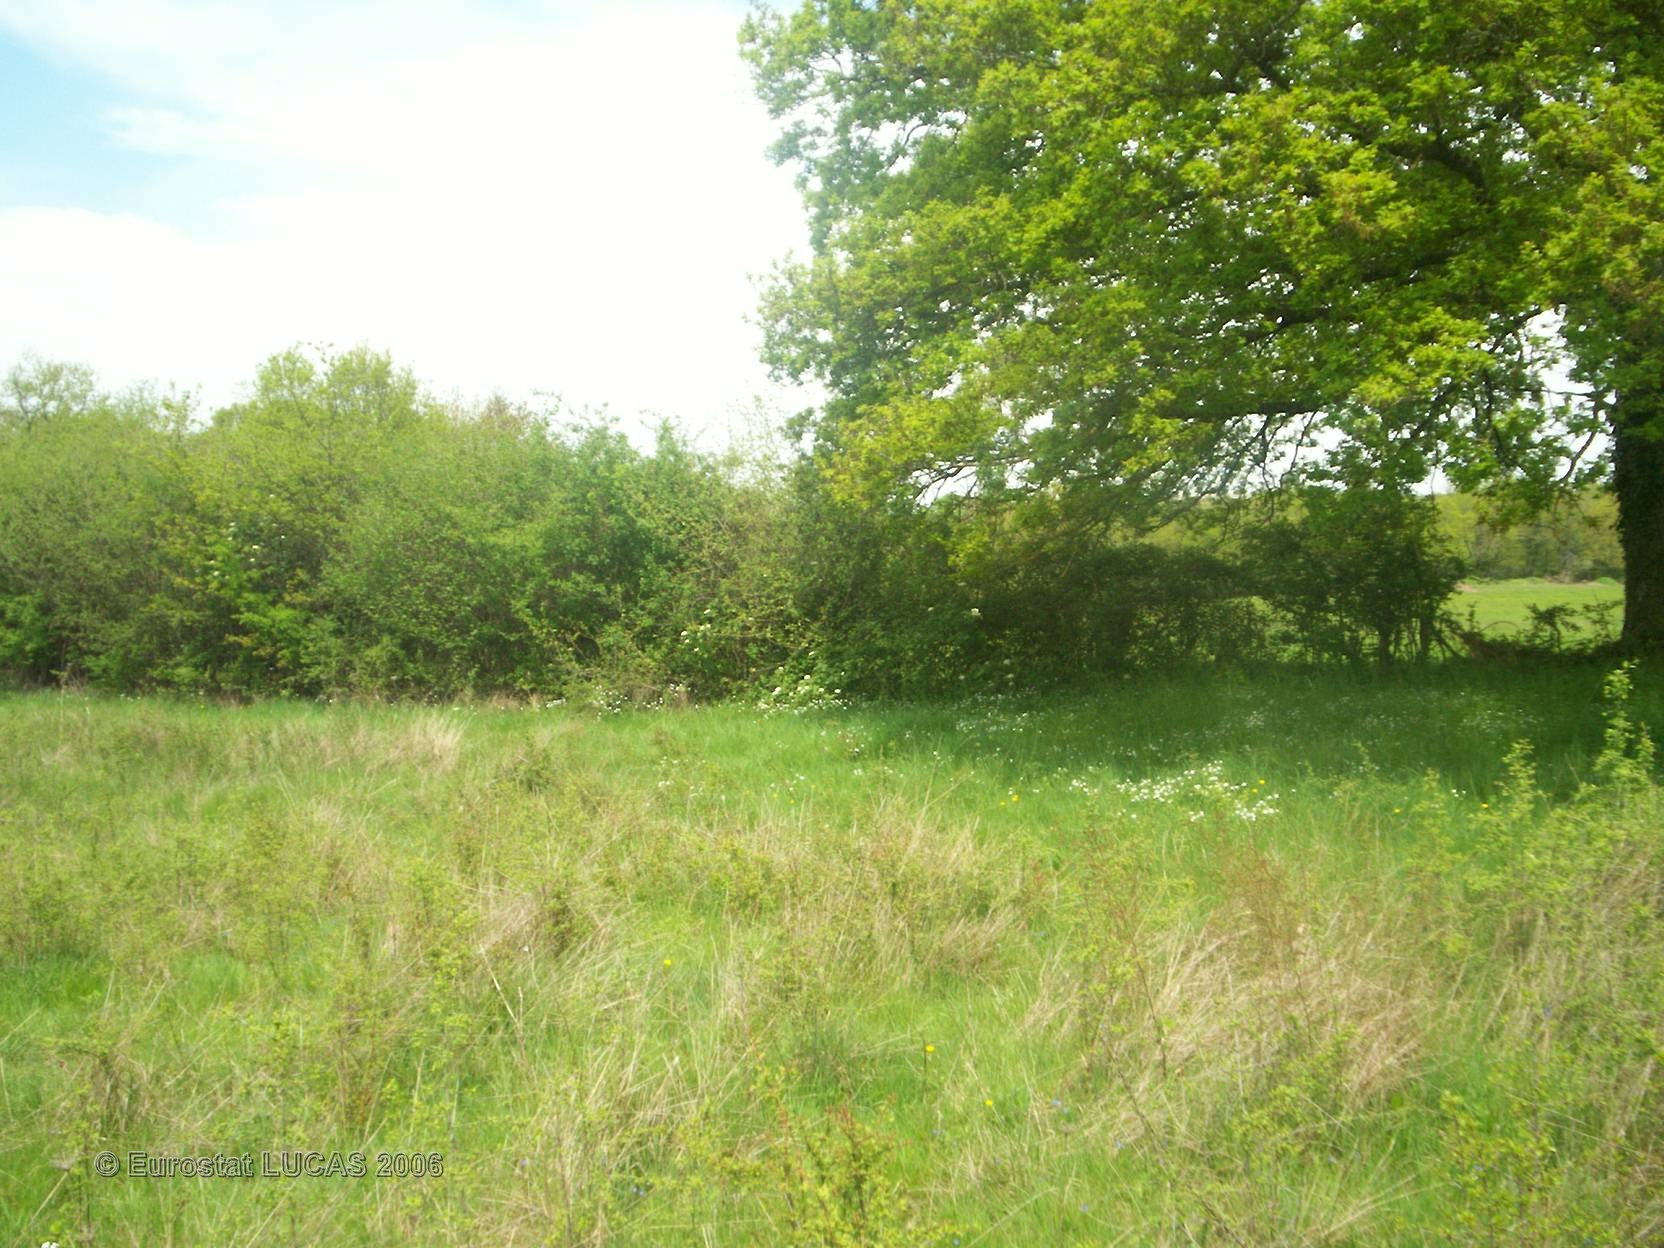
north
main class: Grassland
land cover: Grassland with sparse tree/shrub cover
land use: Unused
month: May
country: FR
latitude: 46.2734
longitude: 3.1077
